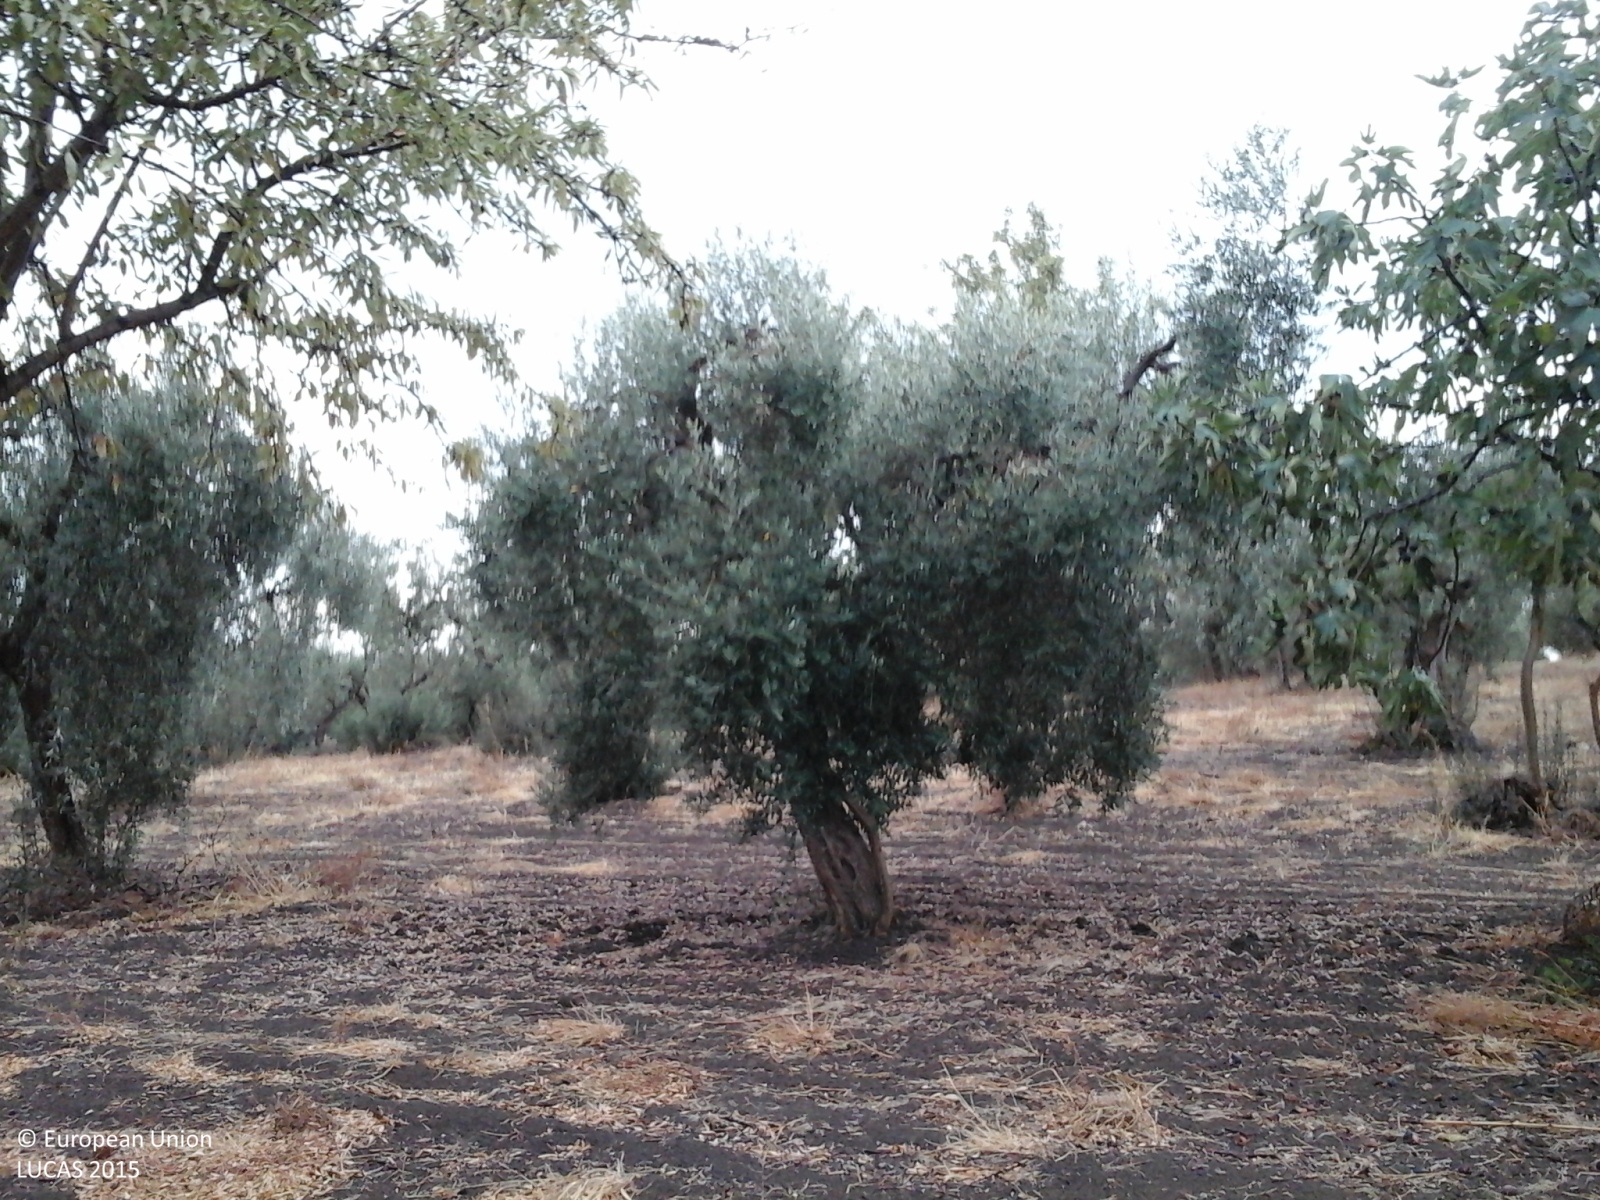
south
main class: Cropland
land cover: Olive groves
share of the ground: > 75 %
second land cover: Other bare soil
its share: > 75 %
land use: Agriculture (excluding fallow land and kitchen gardens)
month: September
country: IT
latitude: 41.7980
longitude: 15.1708
